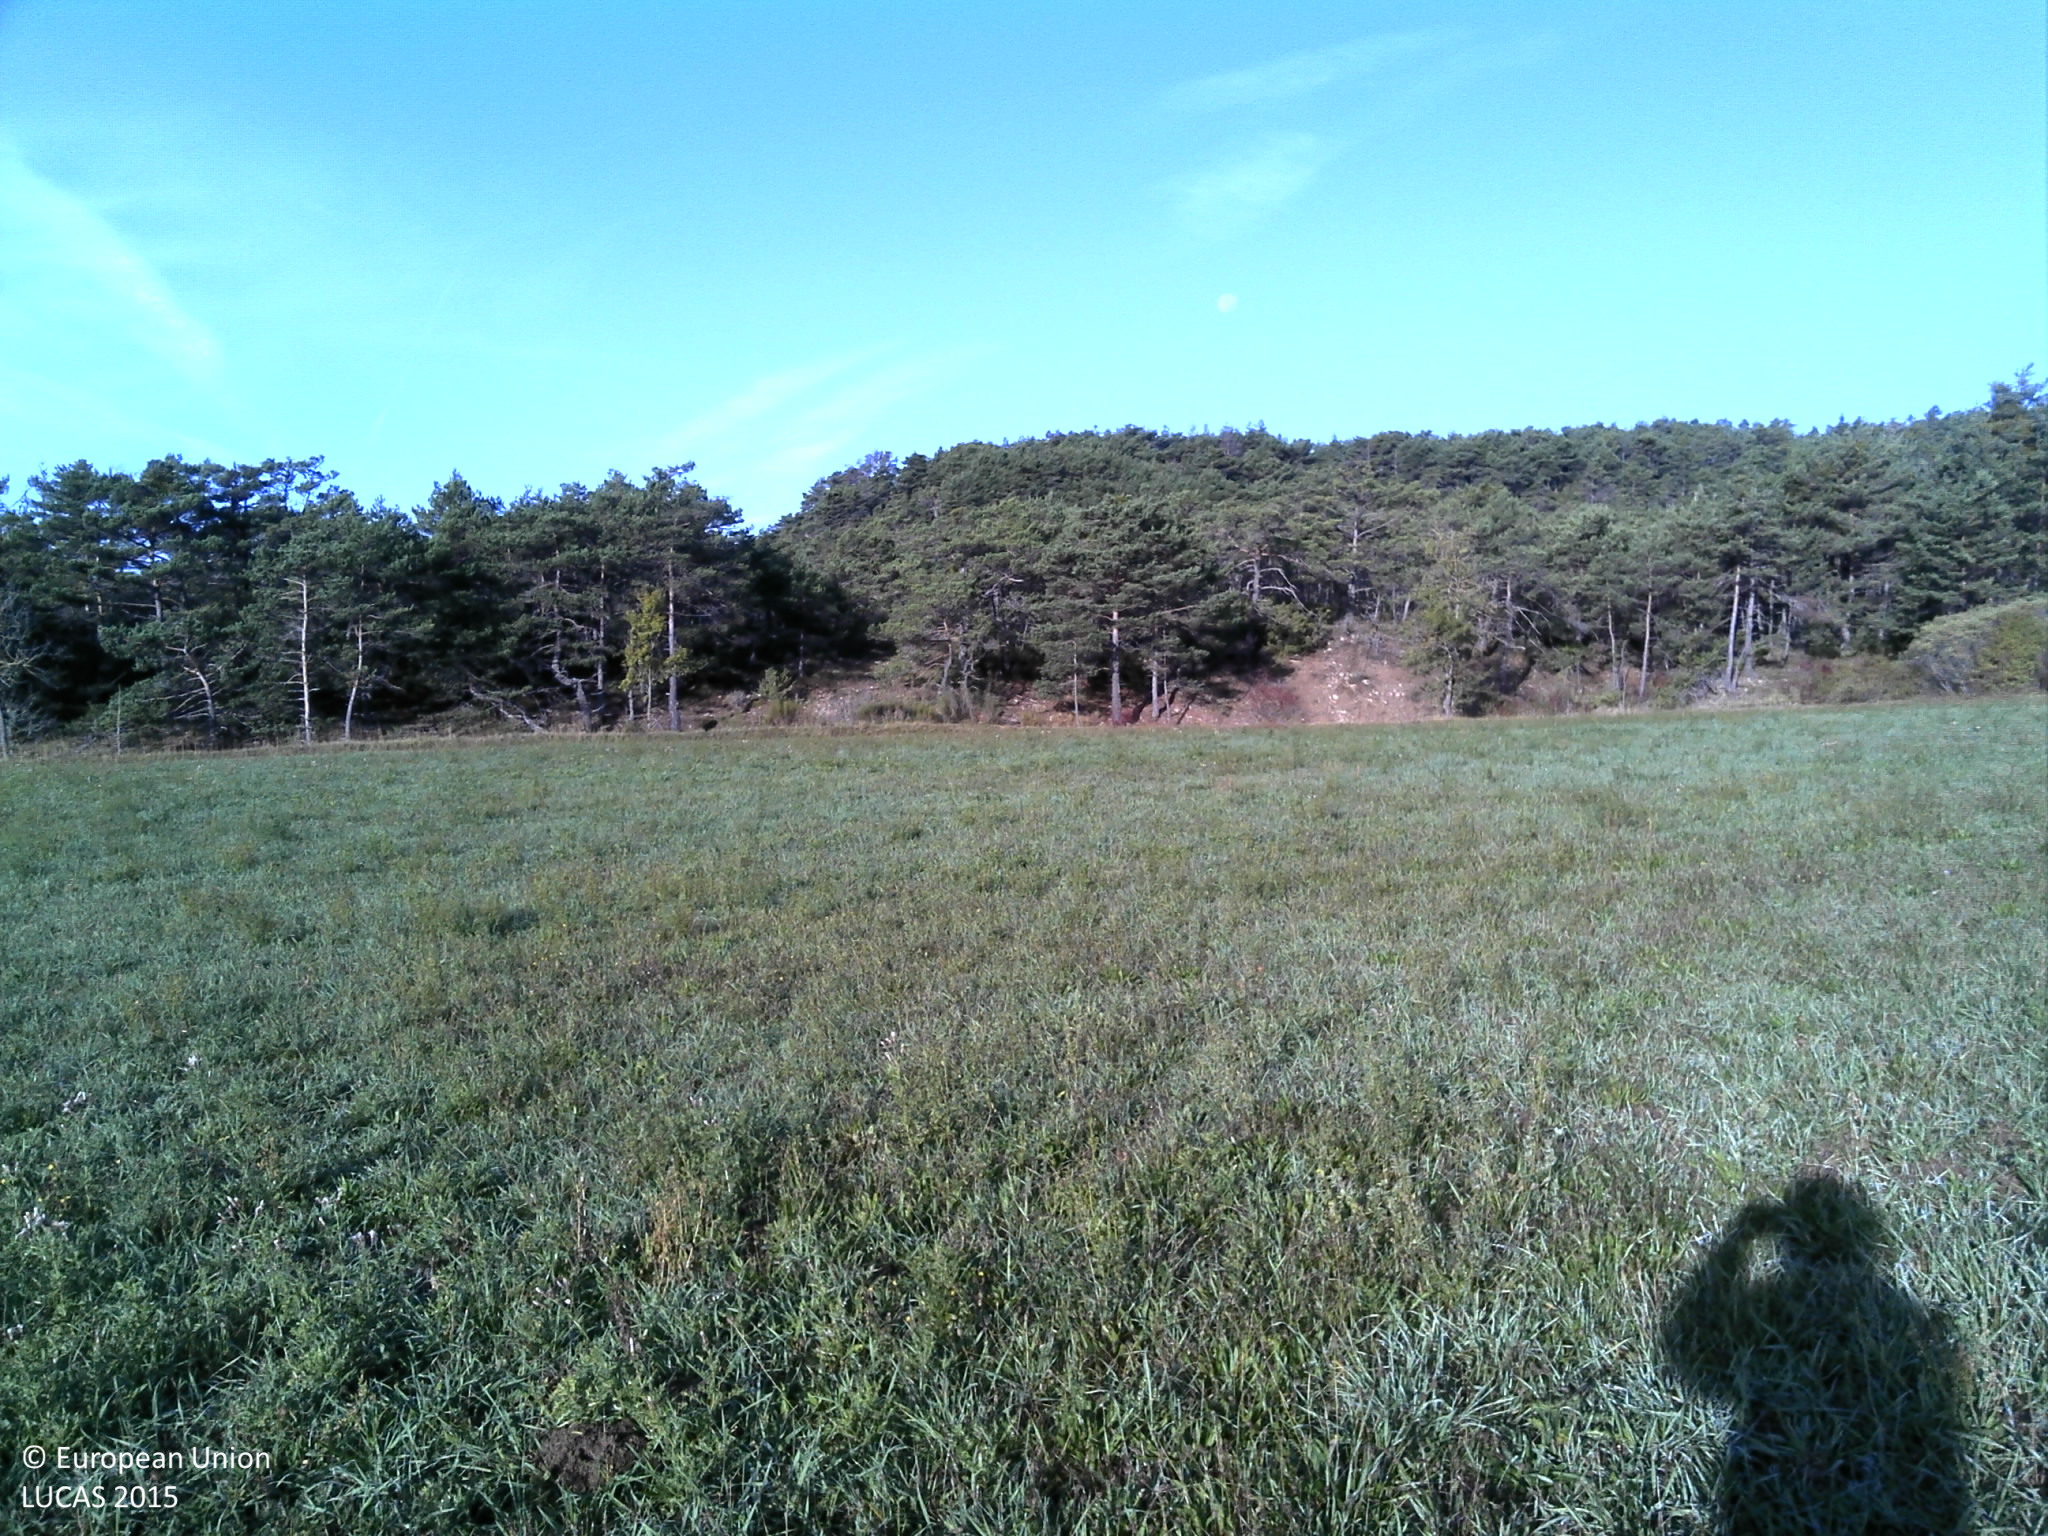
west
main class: Grassland
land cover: Grassland without tree/shrub cover
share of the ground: > 75 %
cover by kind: herbaceous plants 90 %, unconsolidated bare surface 10 %
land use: Agriculture (excluding fallow land and kitchen gardens)
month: September
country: FR
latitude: 43.7161
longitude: 6.5698
